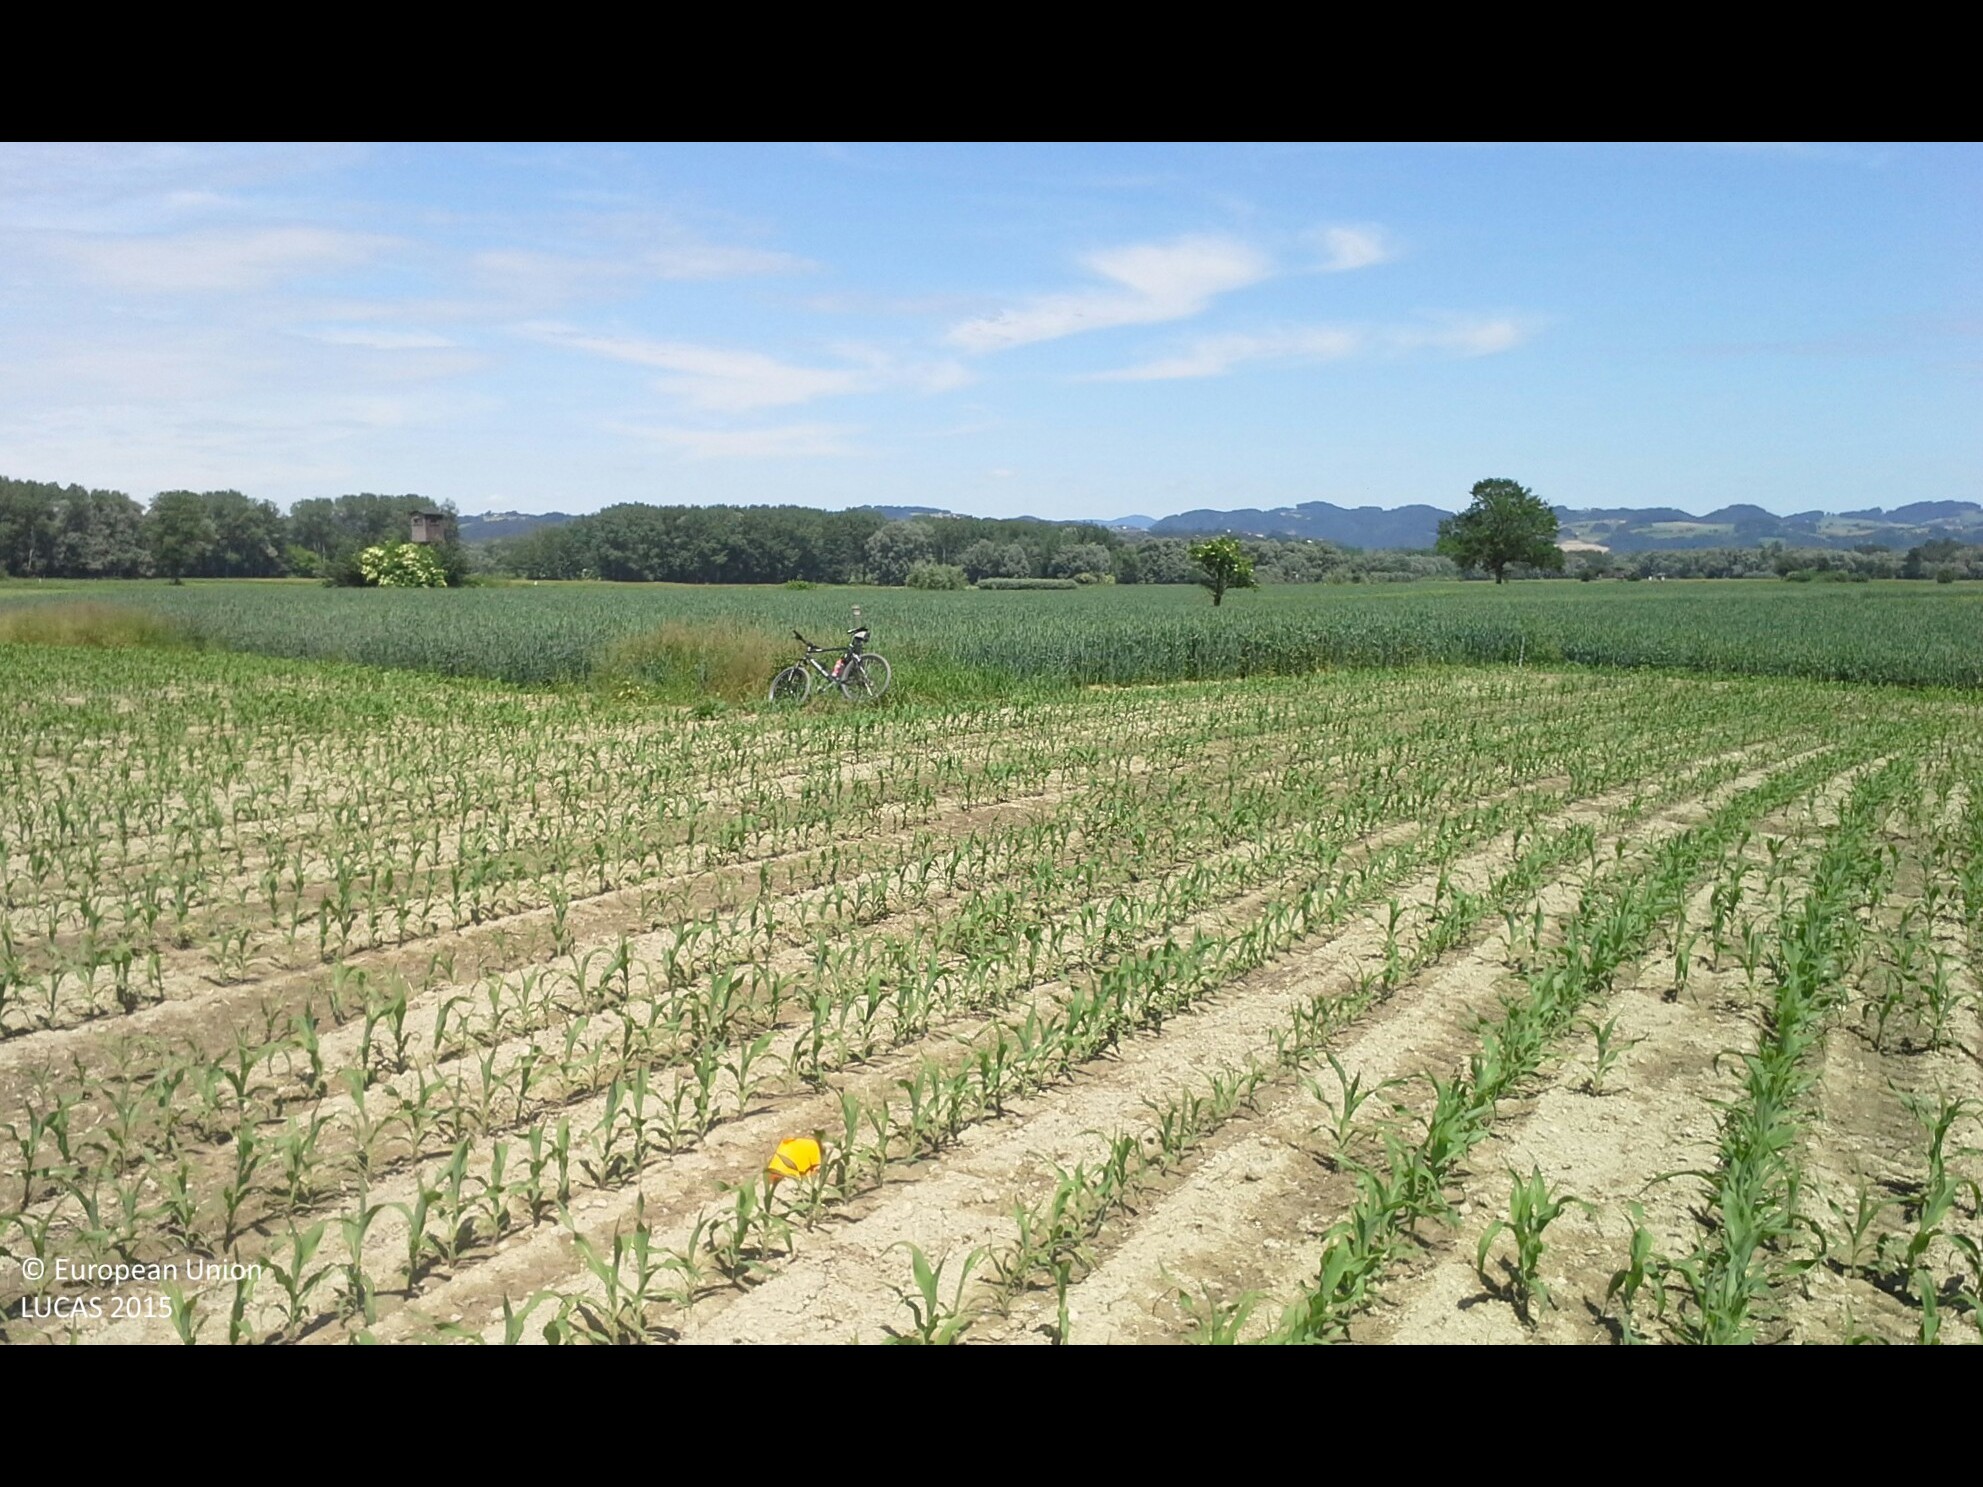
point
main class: Cropland
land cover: Maize
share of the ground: 25 - 50 %
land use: Agriculture (excluding fallow land and kitchen gardens)
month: June
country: AT
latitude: 48.1742
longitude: 14.7747
